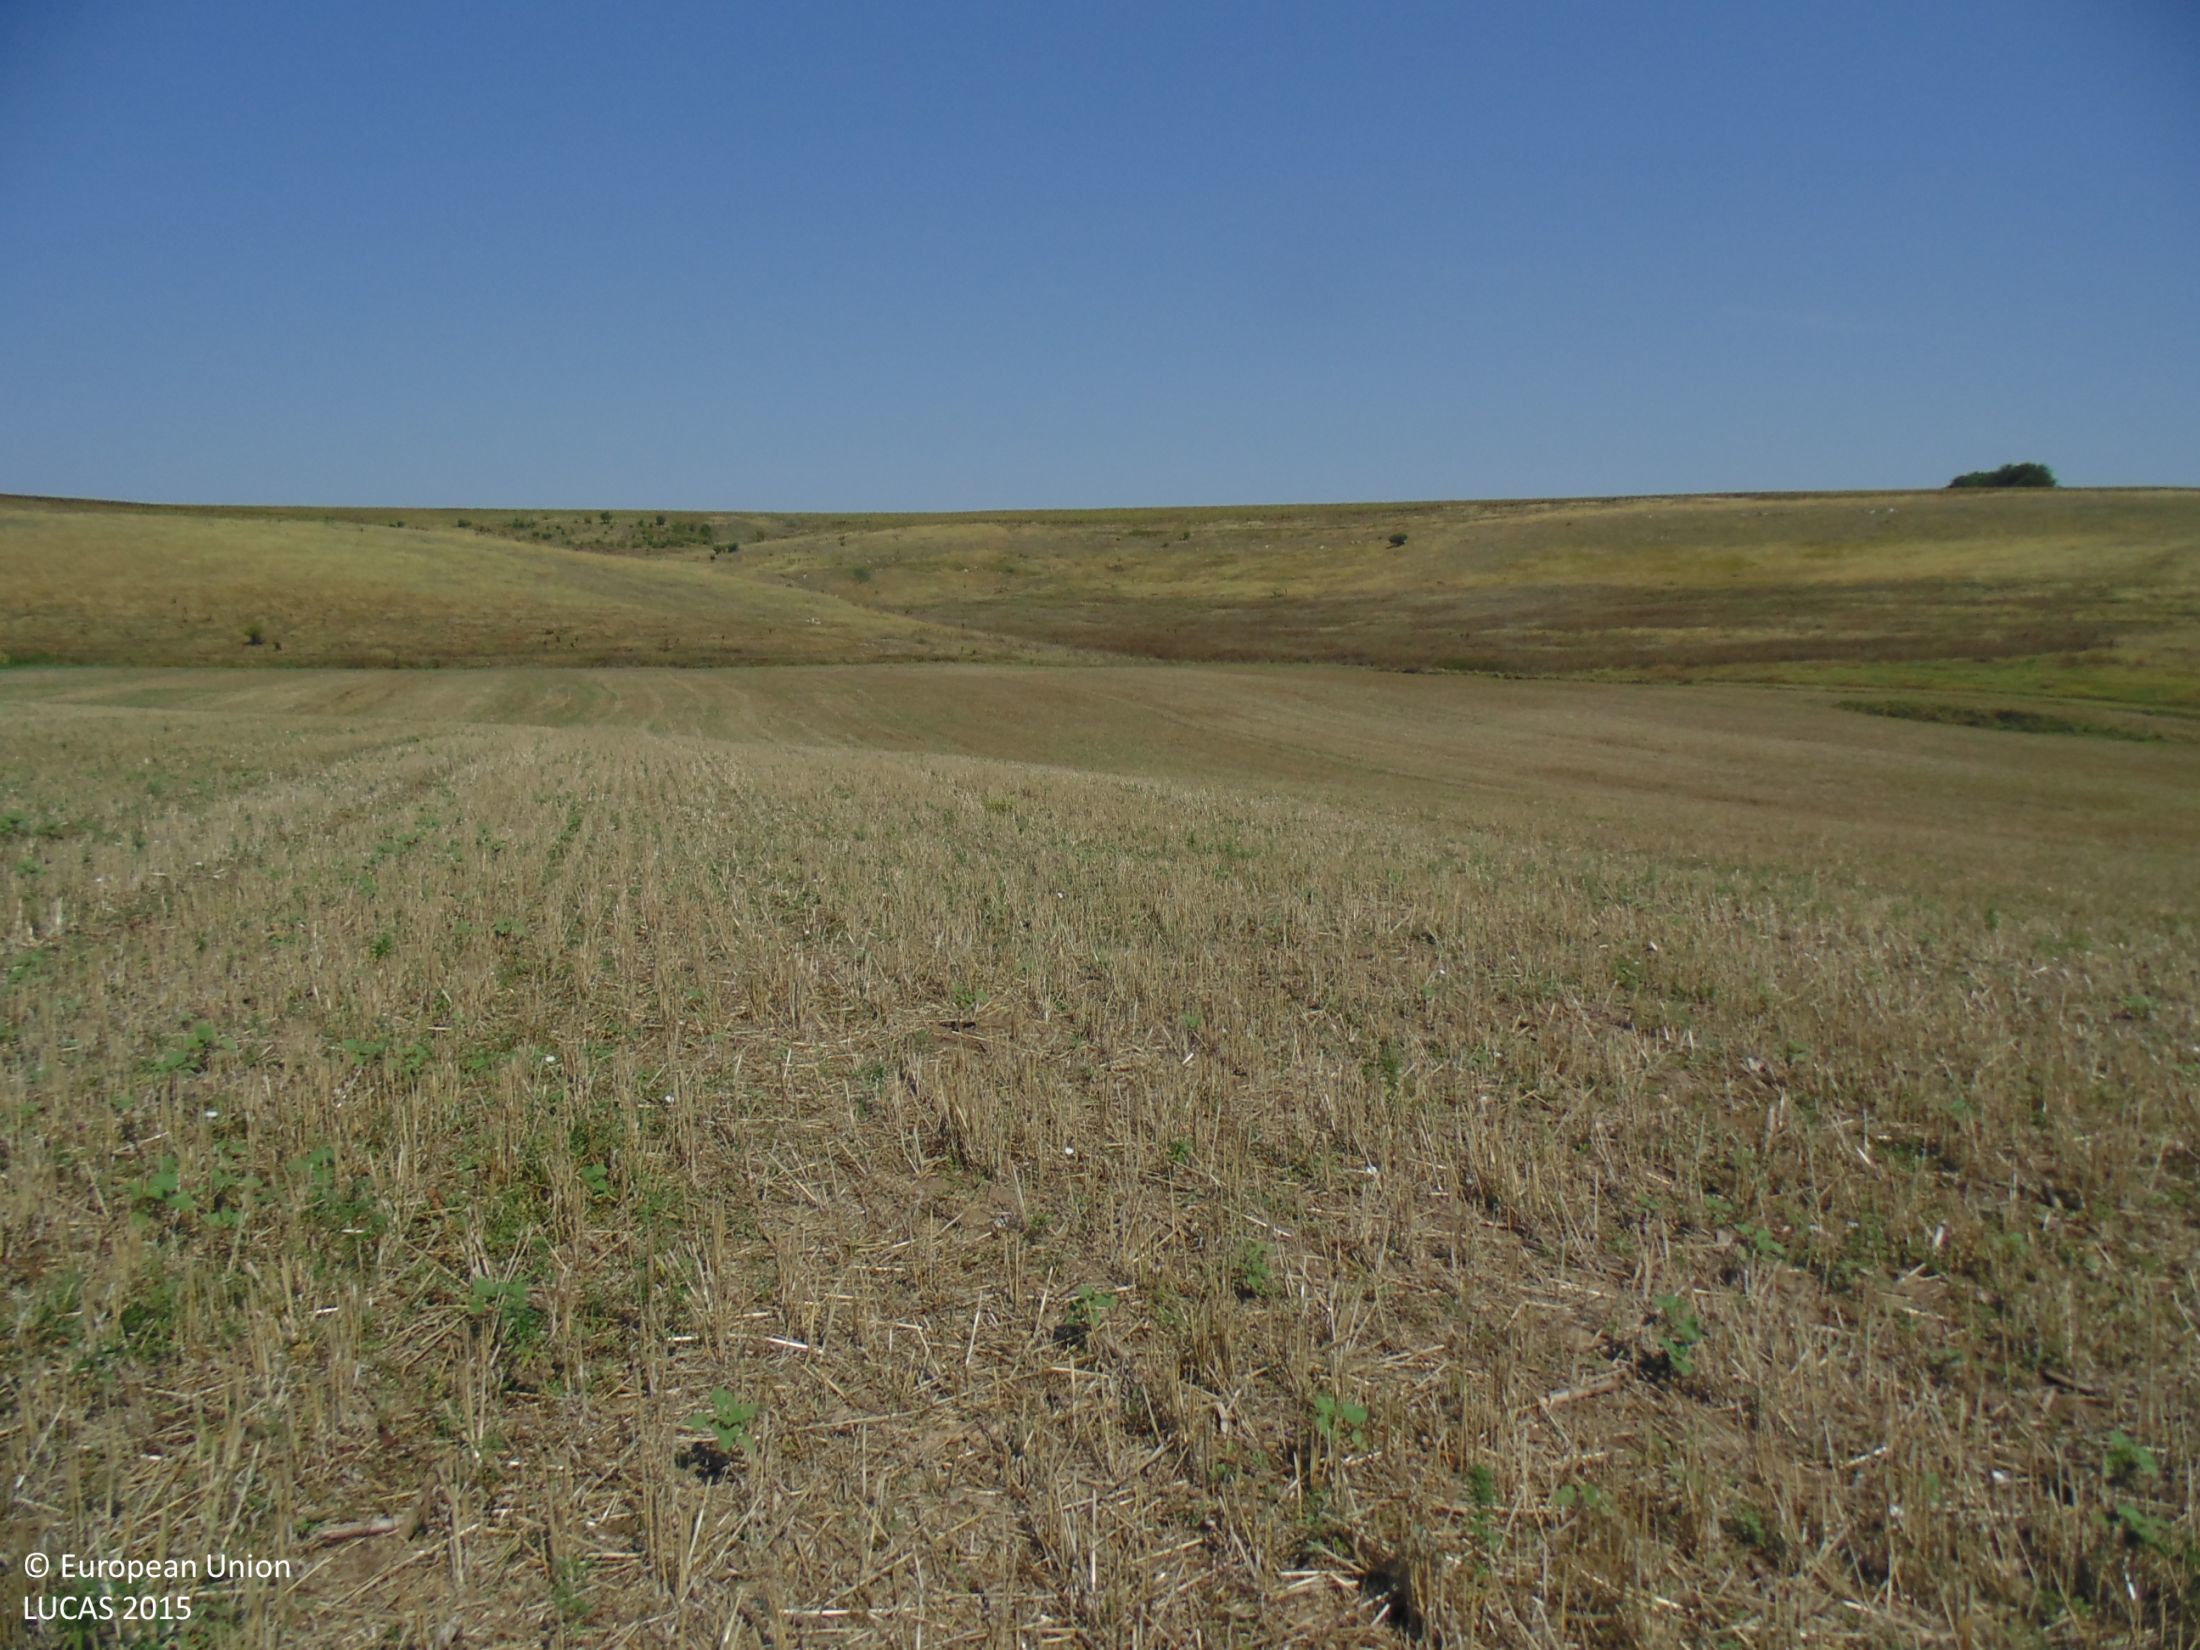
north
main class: Cropland
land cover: Common wheat
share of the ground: 10 - 25 %
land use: Agriculture (excluding fallow land and kitchen gardens)
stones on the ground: < 10 %
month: August
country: BG
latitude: 43.7022
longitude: 27.4680
